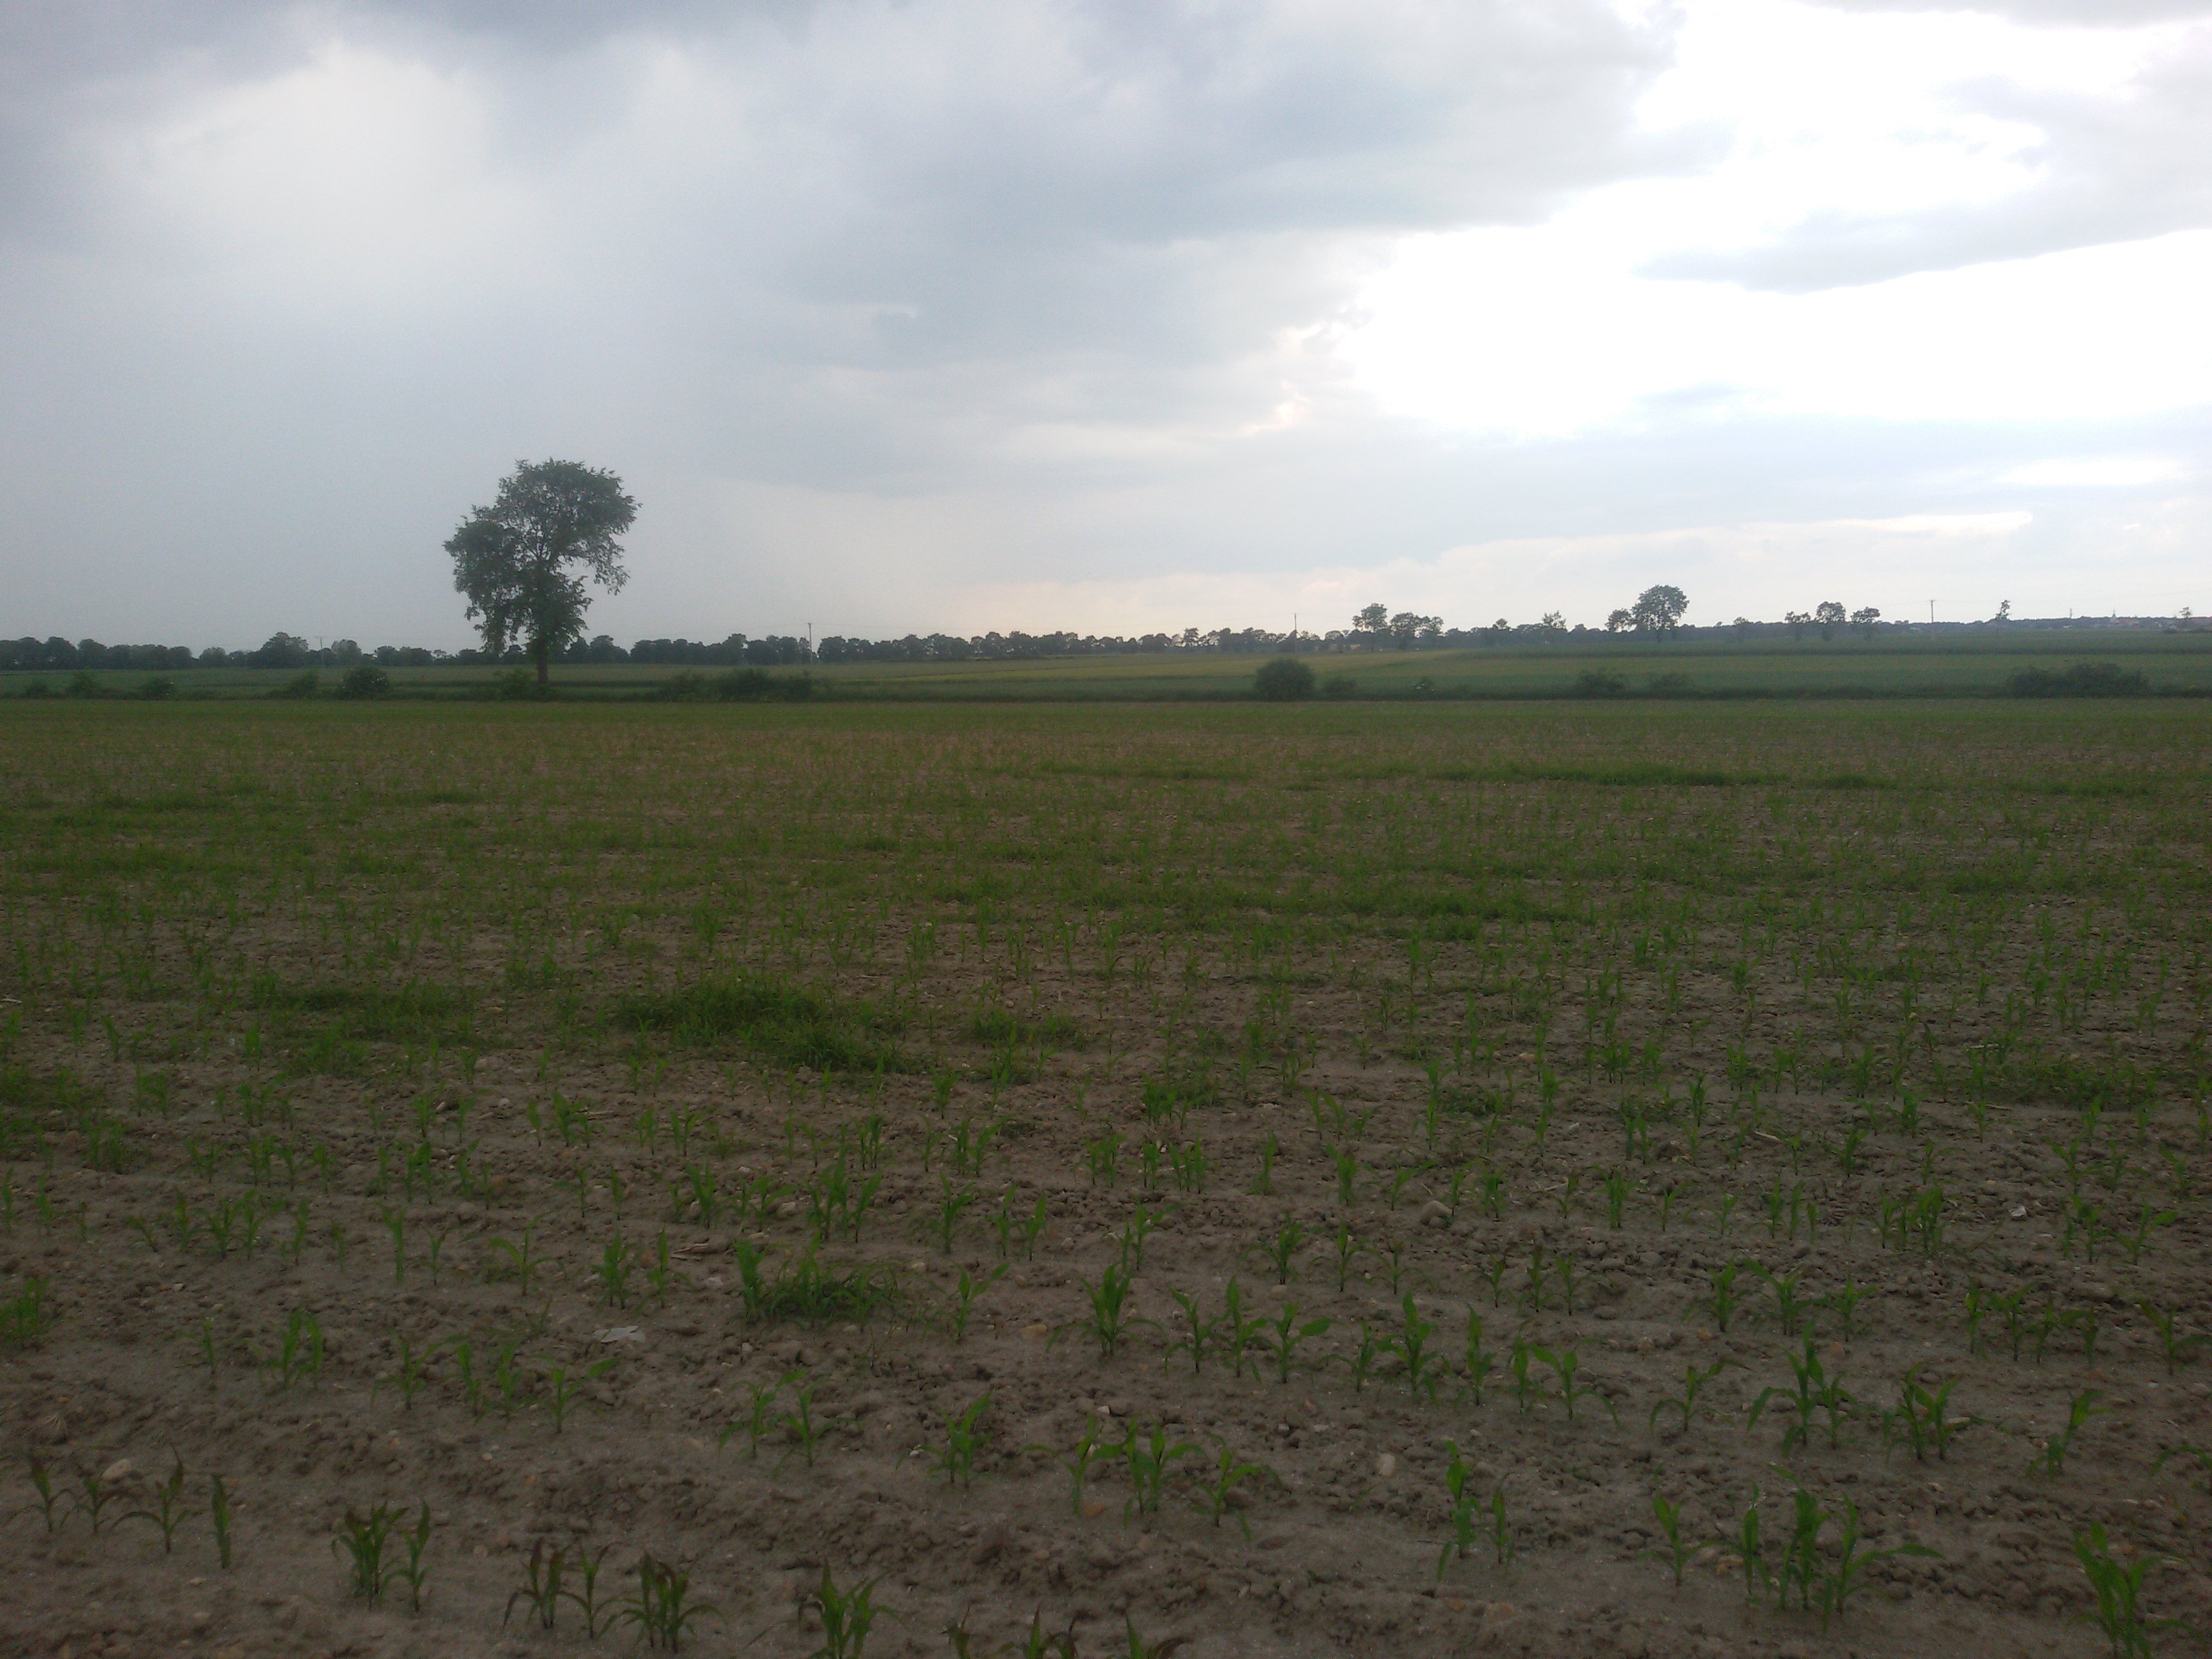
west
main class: Cropland
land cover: Maize
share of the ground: < 10 %
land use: Agriculture (excluding fallow land and kitchen gardens)
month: June
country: PL
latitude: 50.4699
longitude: 17.6358
